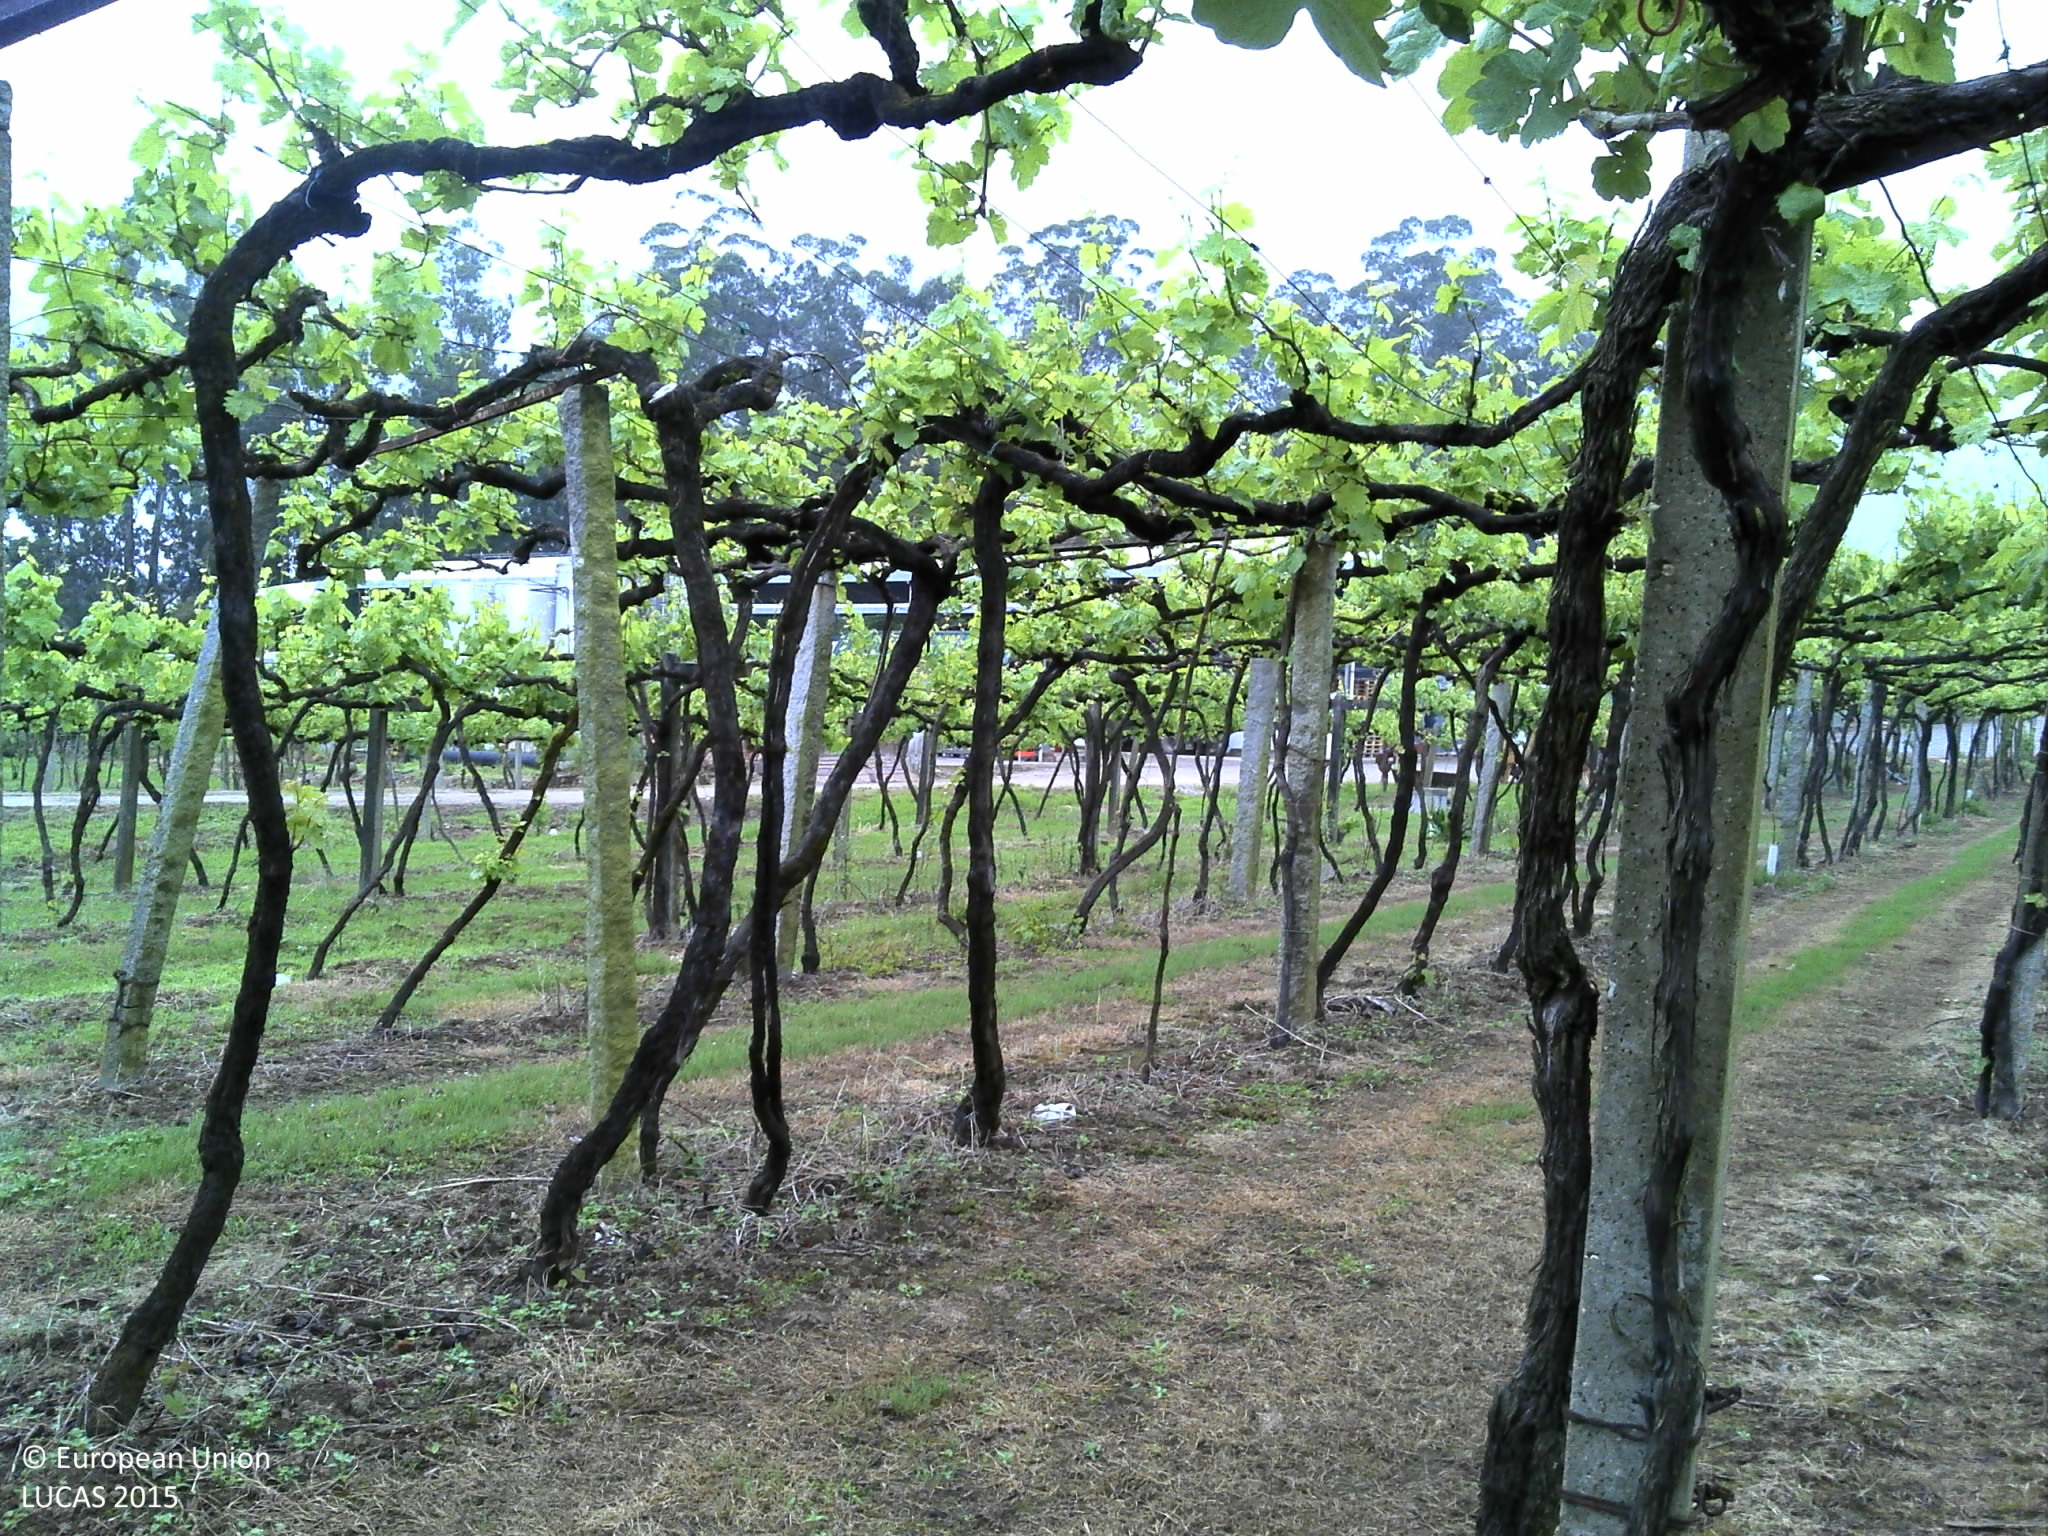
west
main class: Cropland
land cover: Vineyards
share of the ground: 50 - 75 %
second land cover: Grassland without tree/shrub cover
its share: 10 - 25 %
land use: Agriculture (excluding fallow land and kitchen gardens)
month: May
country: PT
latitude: 41.1997
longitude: -8.4530
